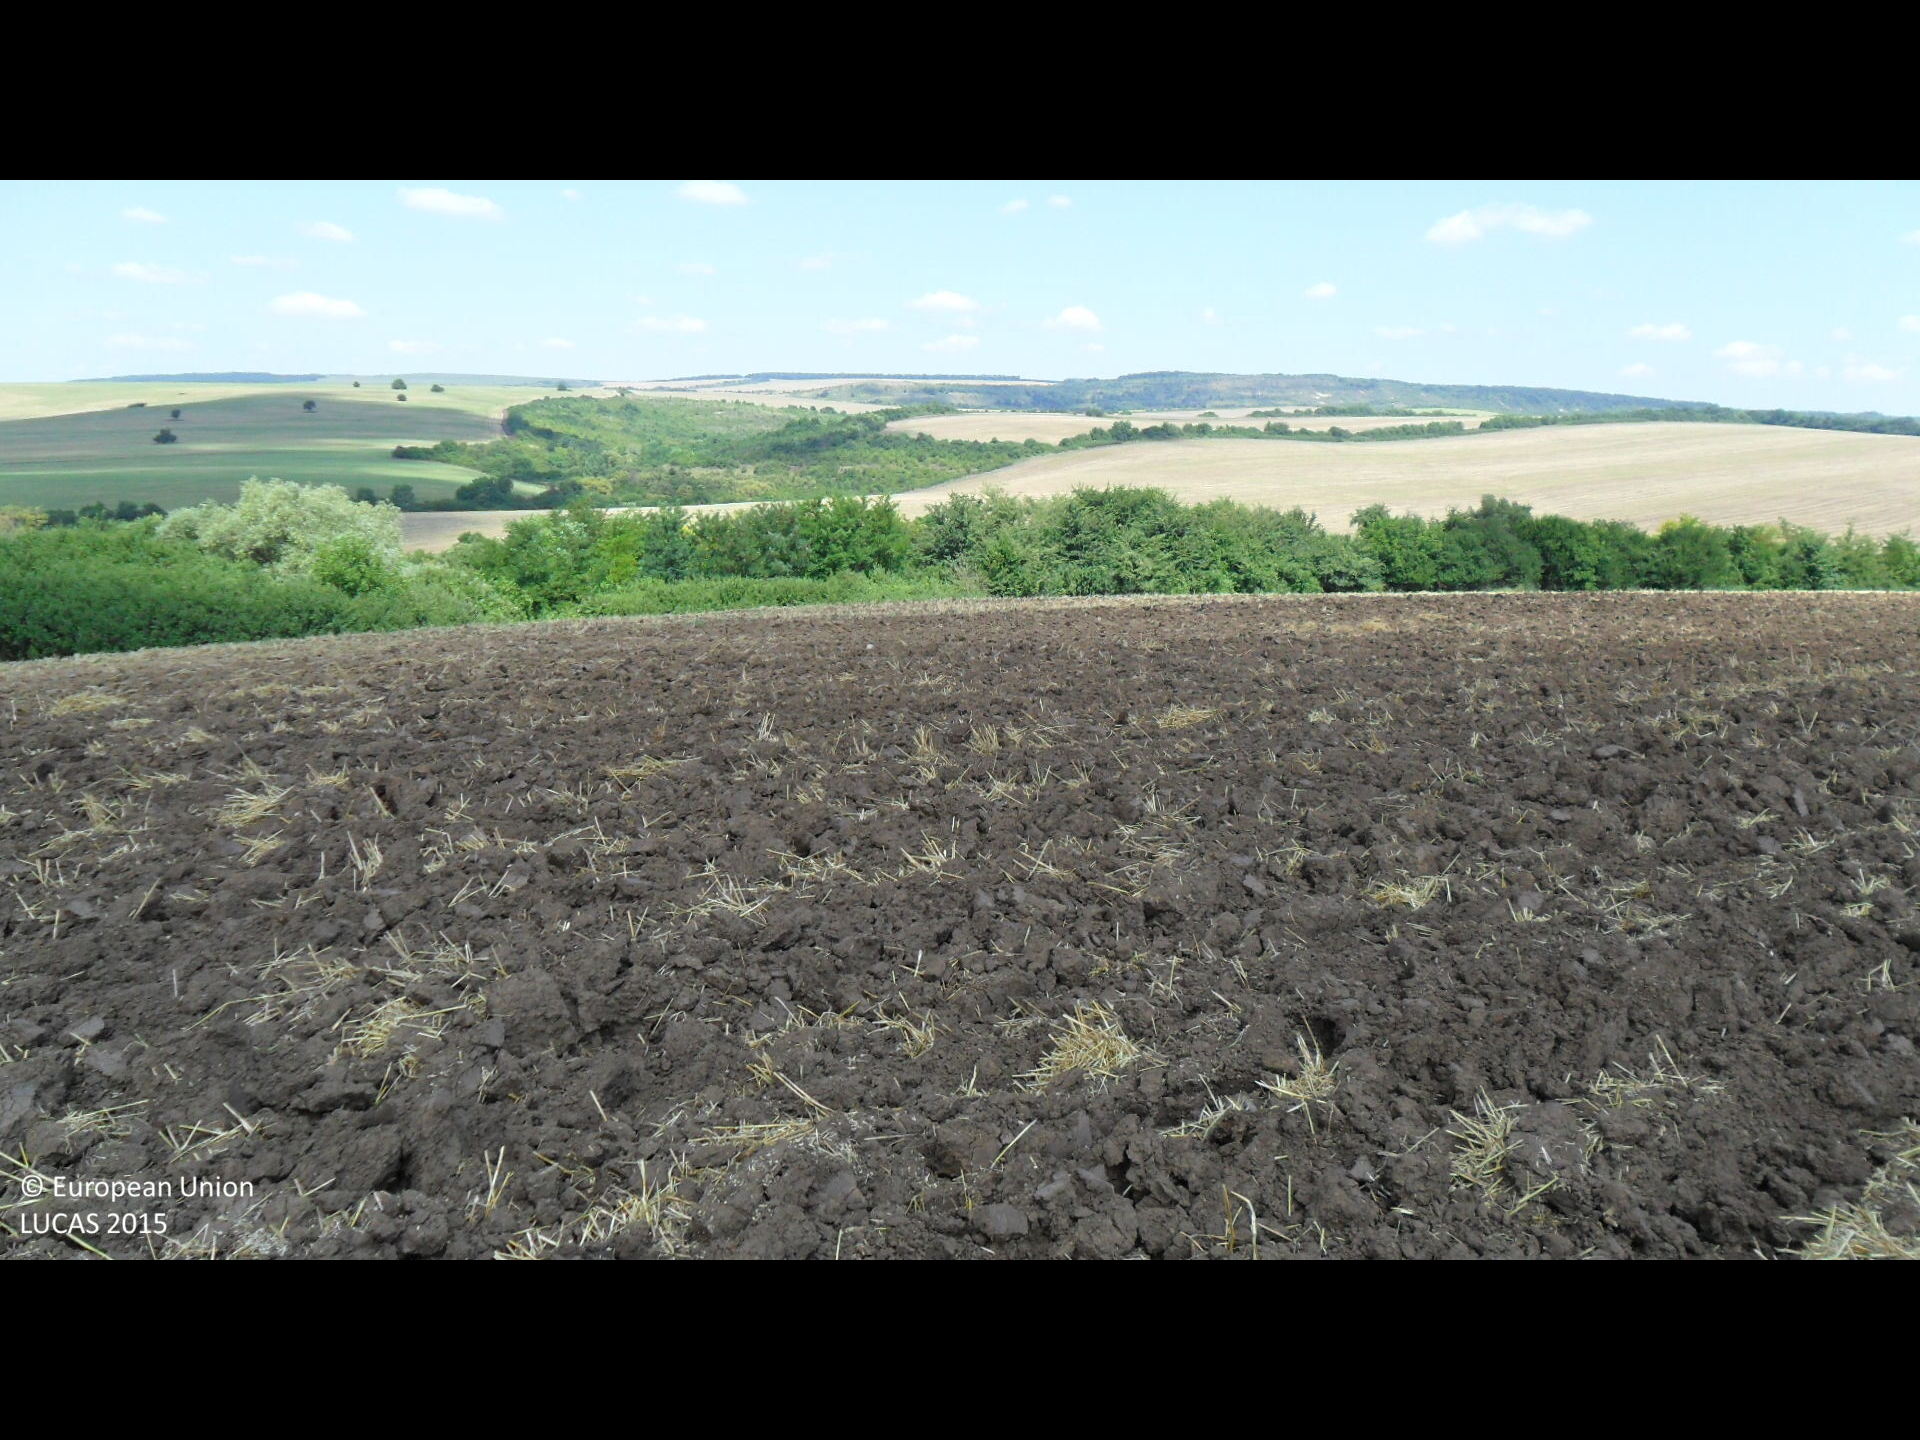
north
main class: Cropland
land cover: Common wheat
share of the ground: 25 - 50 %
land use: Agriculture (excluding fallow land and kitchen gardens)
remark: Harvested field
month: August
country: BG
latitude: 43.4435
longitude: 26.3737
